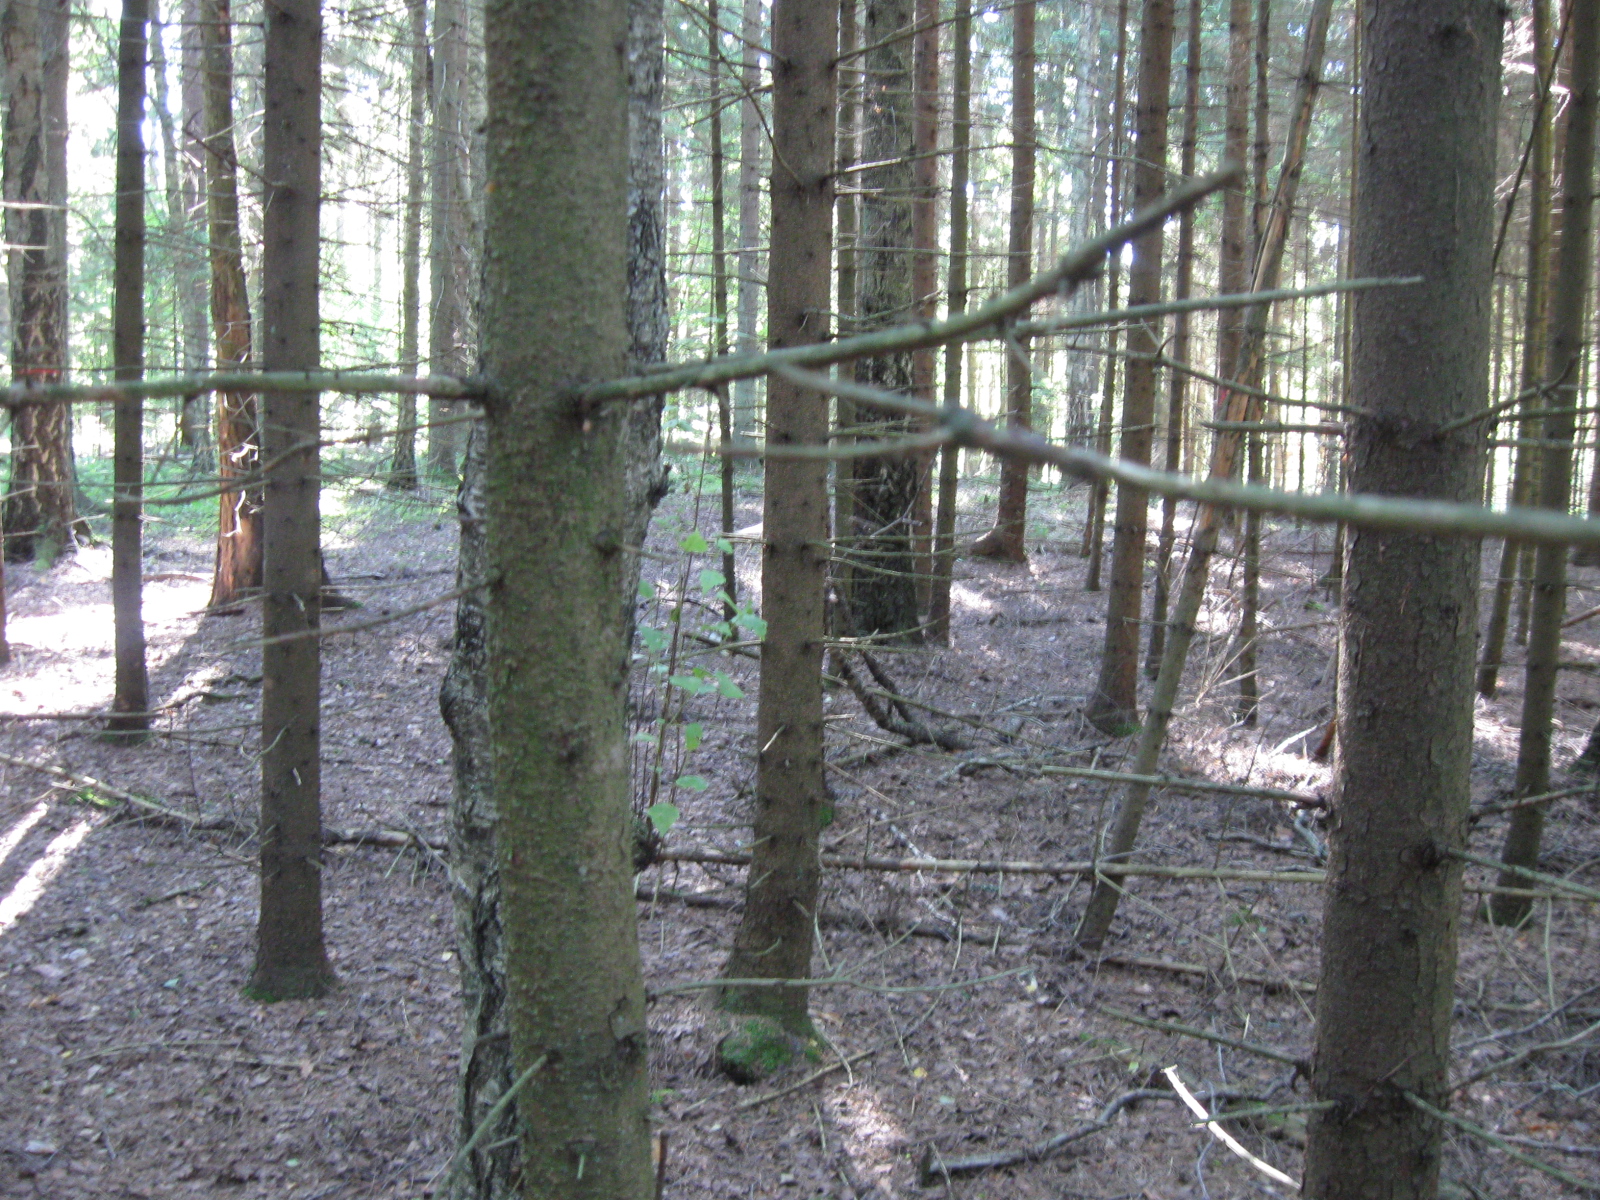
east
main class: Woodland
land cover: Spruce dominated coniferous woodland
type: hemiboreal forest and nemoral coniferous forest and mixed broadleaved-coniferous forest
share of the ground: > 75 %
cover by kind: coniferous forest trees 95 %, broadleaved forest trees 5 %
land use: Forestry
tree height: > 5 m
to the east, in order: Spruce dominated coniferous woodland; Other structural elements; Spruce dominated coniferous woodland; Paved roads, cycling and walking lanes; Spontaneously vegetated surfaces; Electric lines; Spontaneously vegetated surfaces; Spruce dominated mixed woodland
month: June
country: LT
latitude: 54.0711
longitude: 24.7026
